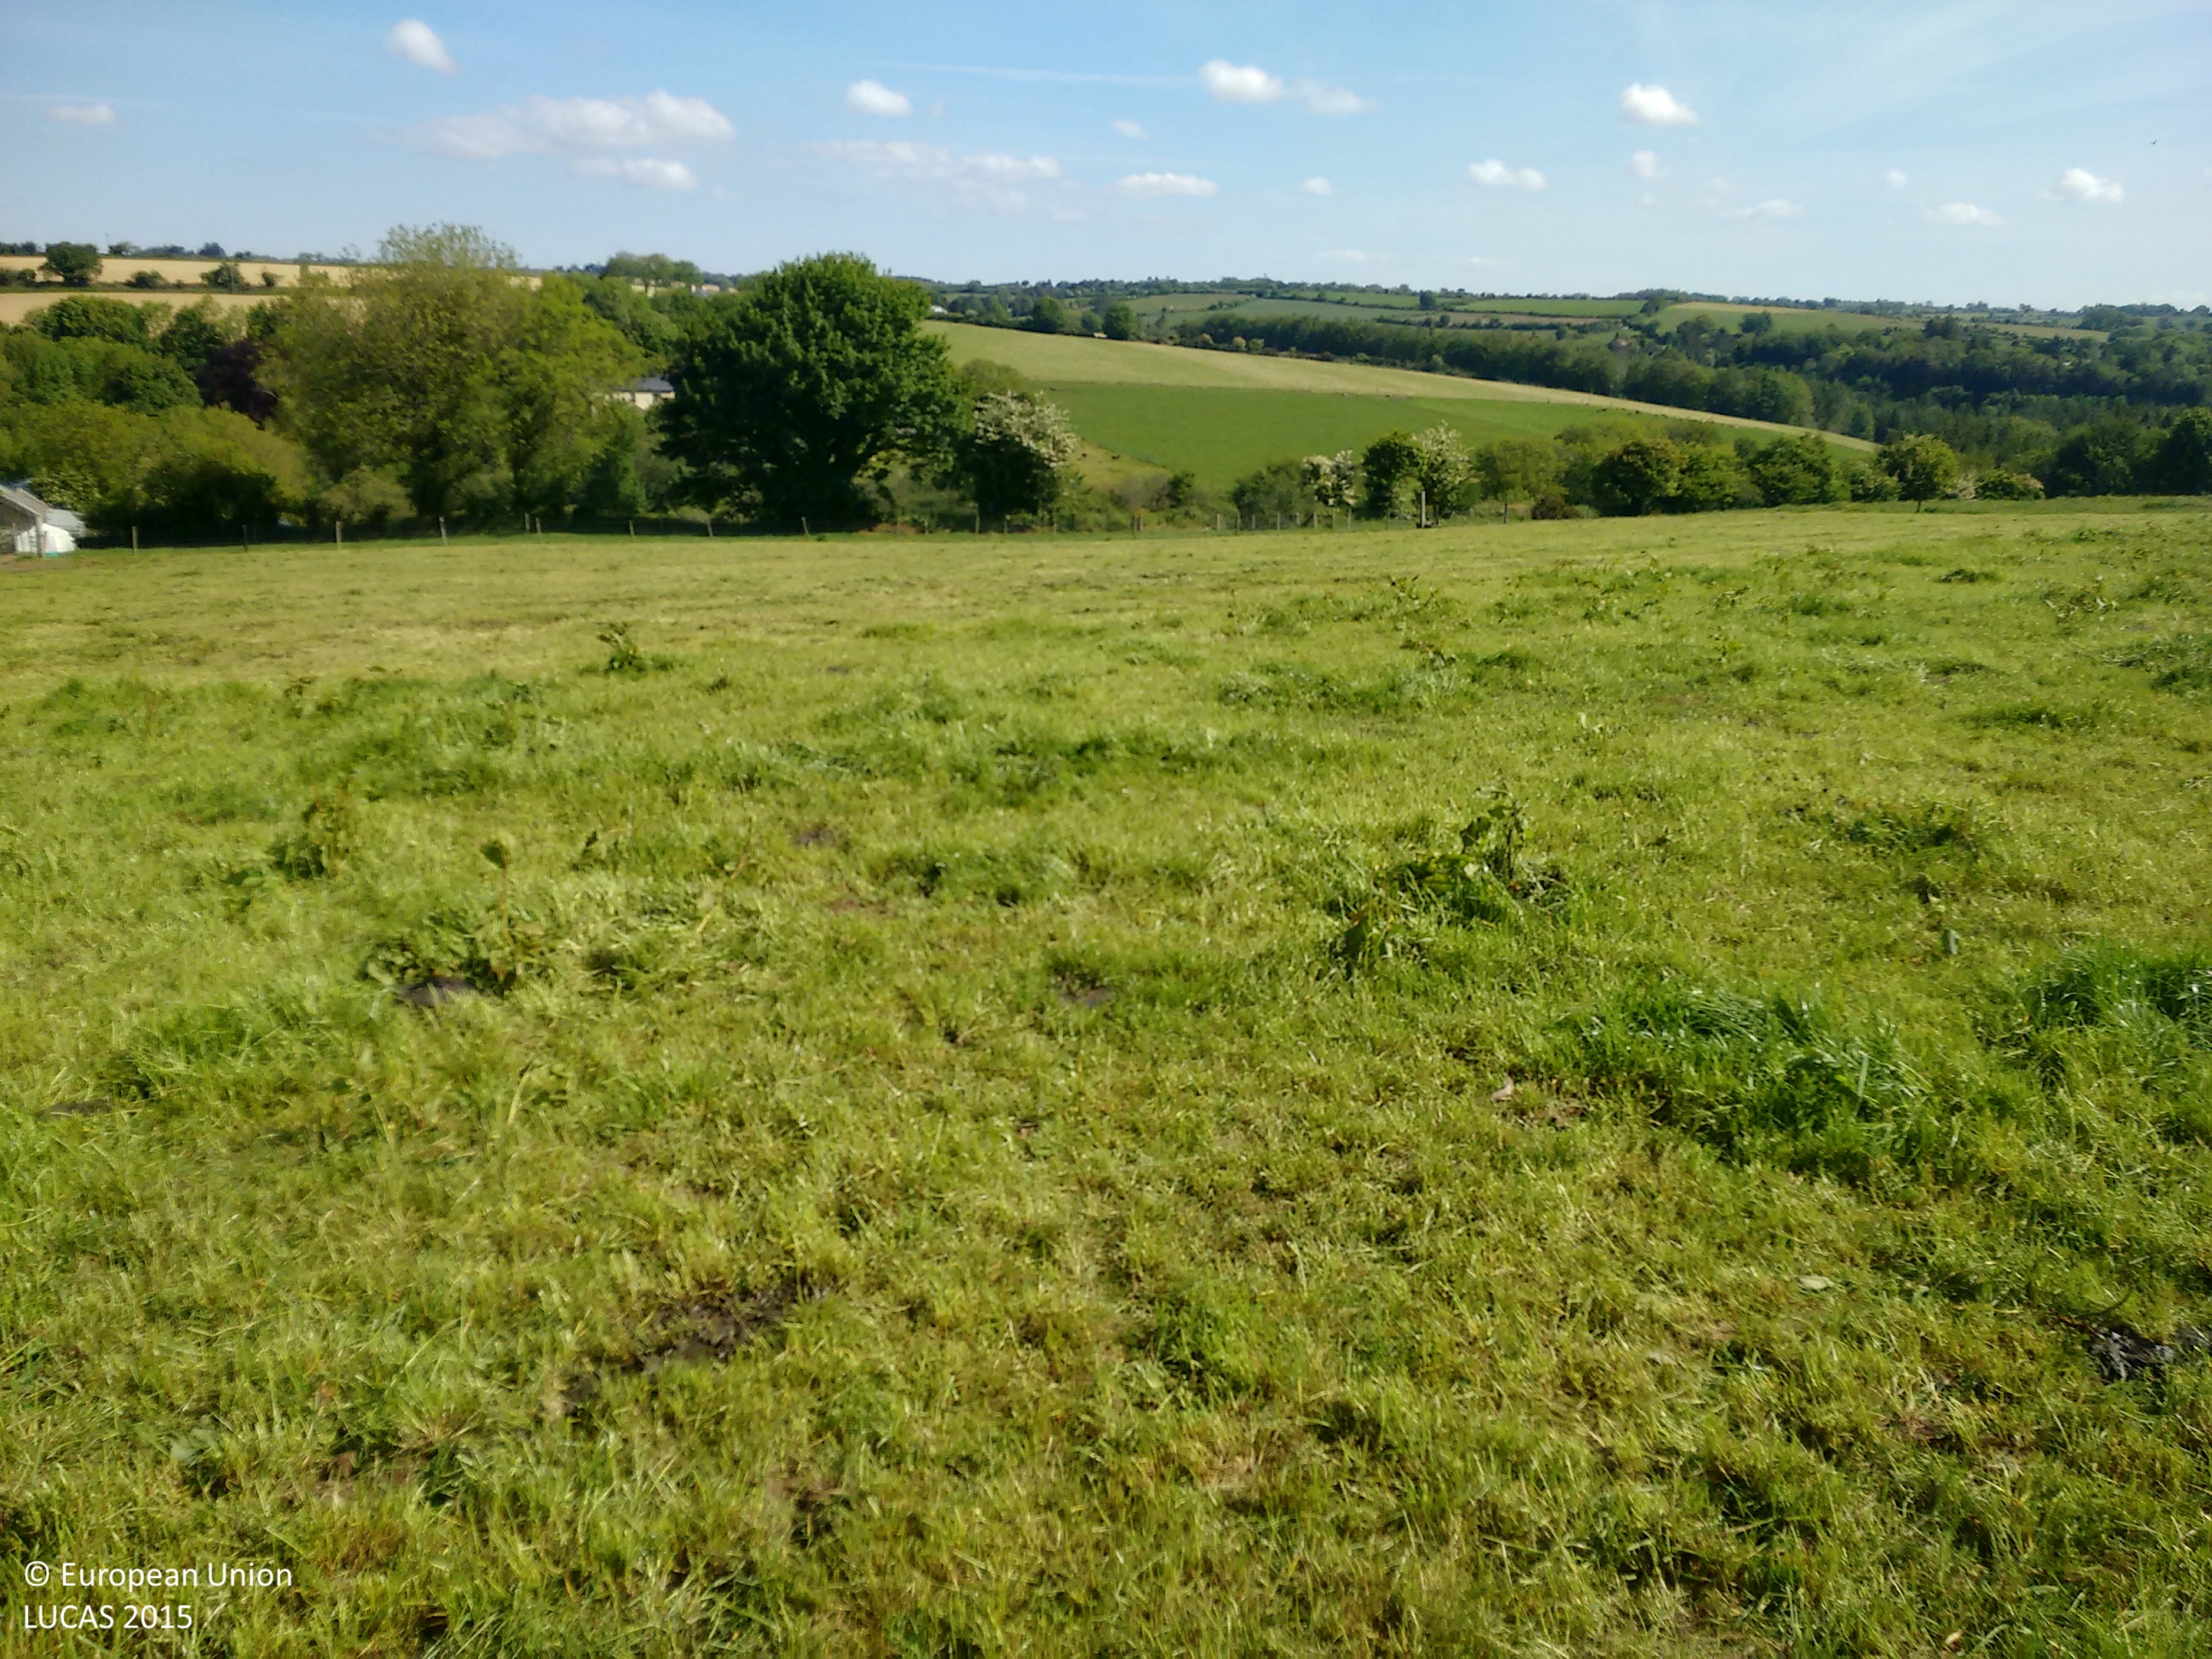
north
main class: Grassland
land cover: Grassland without tree/shrub cover
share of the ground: > 75 %
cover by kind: herbaceous plants 100 %
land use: Agriculture (excluding fallow land and kitchen gardens)
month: June
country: IE
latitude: 51.7837
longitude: -8.7735
